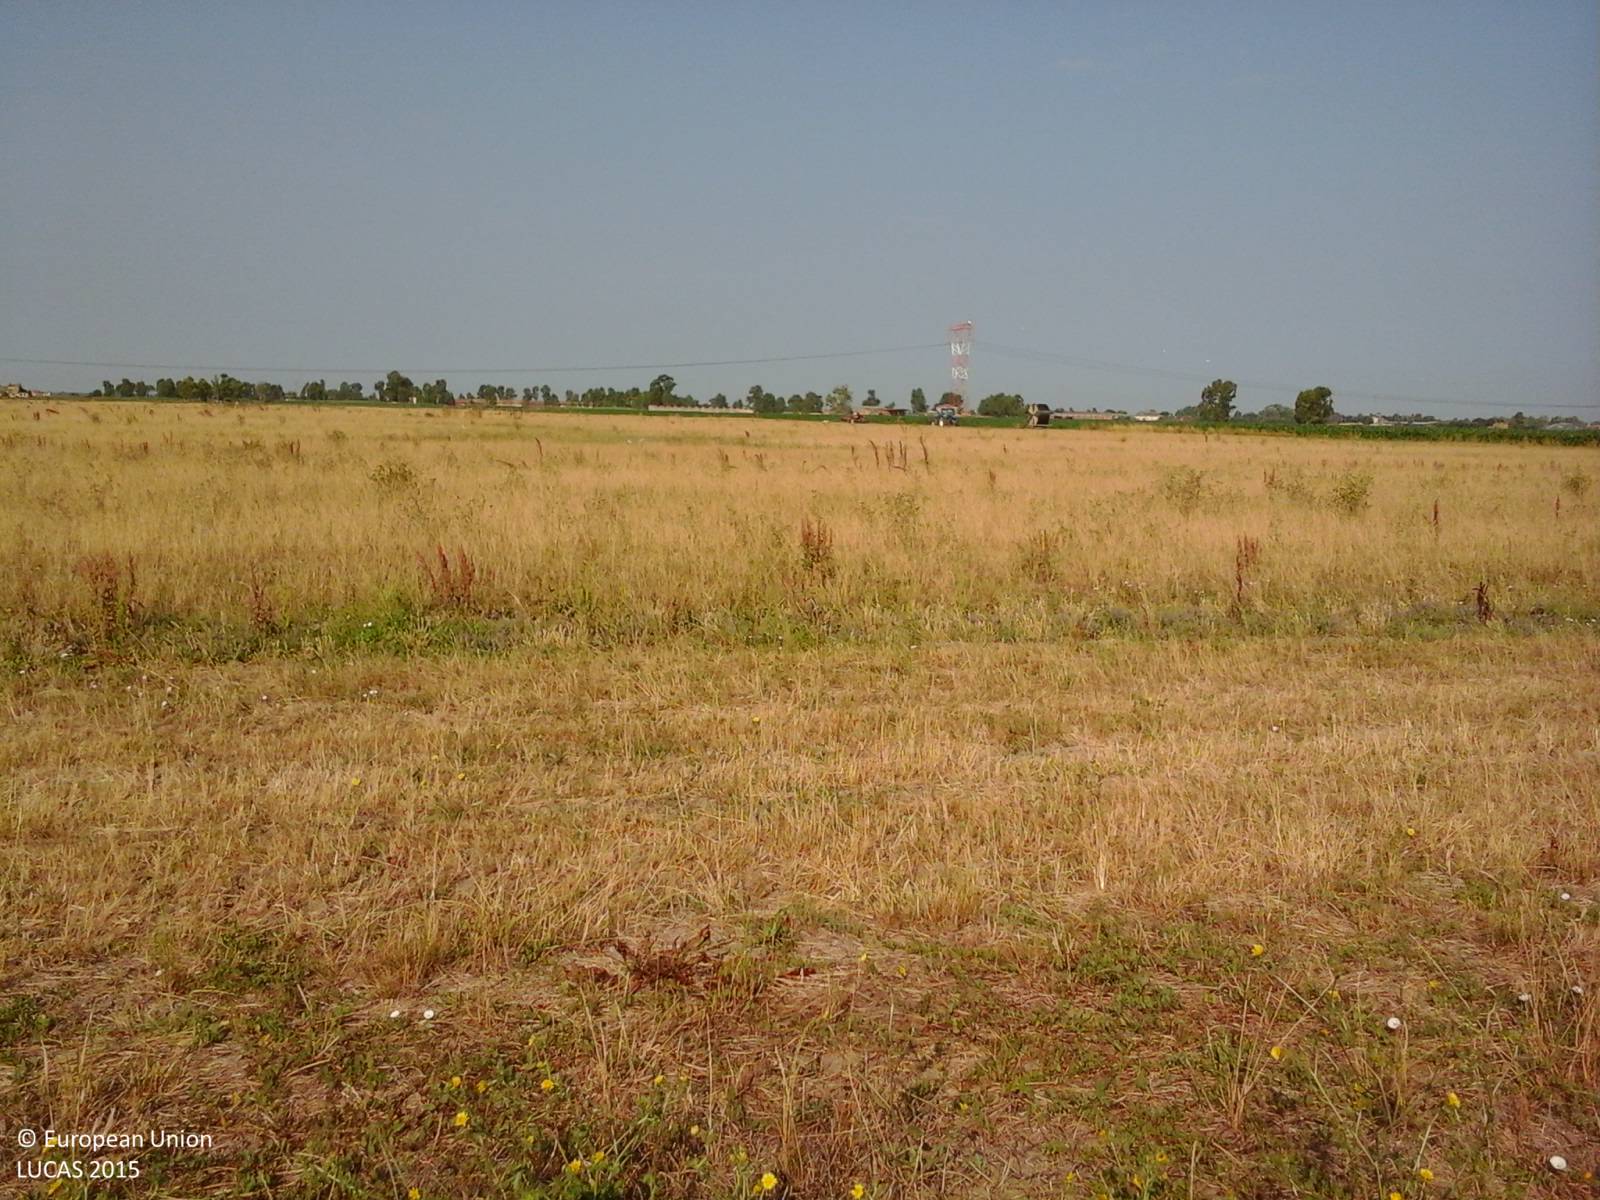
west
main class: Cropland
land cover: Temporary grasslands
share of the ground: > 75 %
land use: Agriculture (excluding fallow land and kitchen gardens)
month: July
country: IT
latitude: 41.0355
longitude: 14.0396
